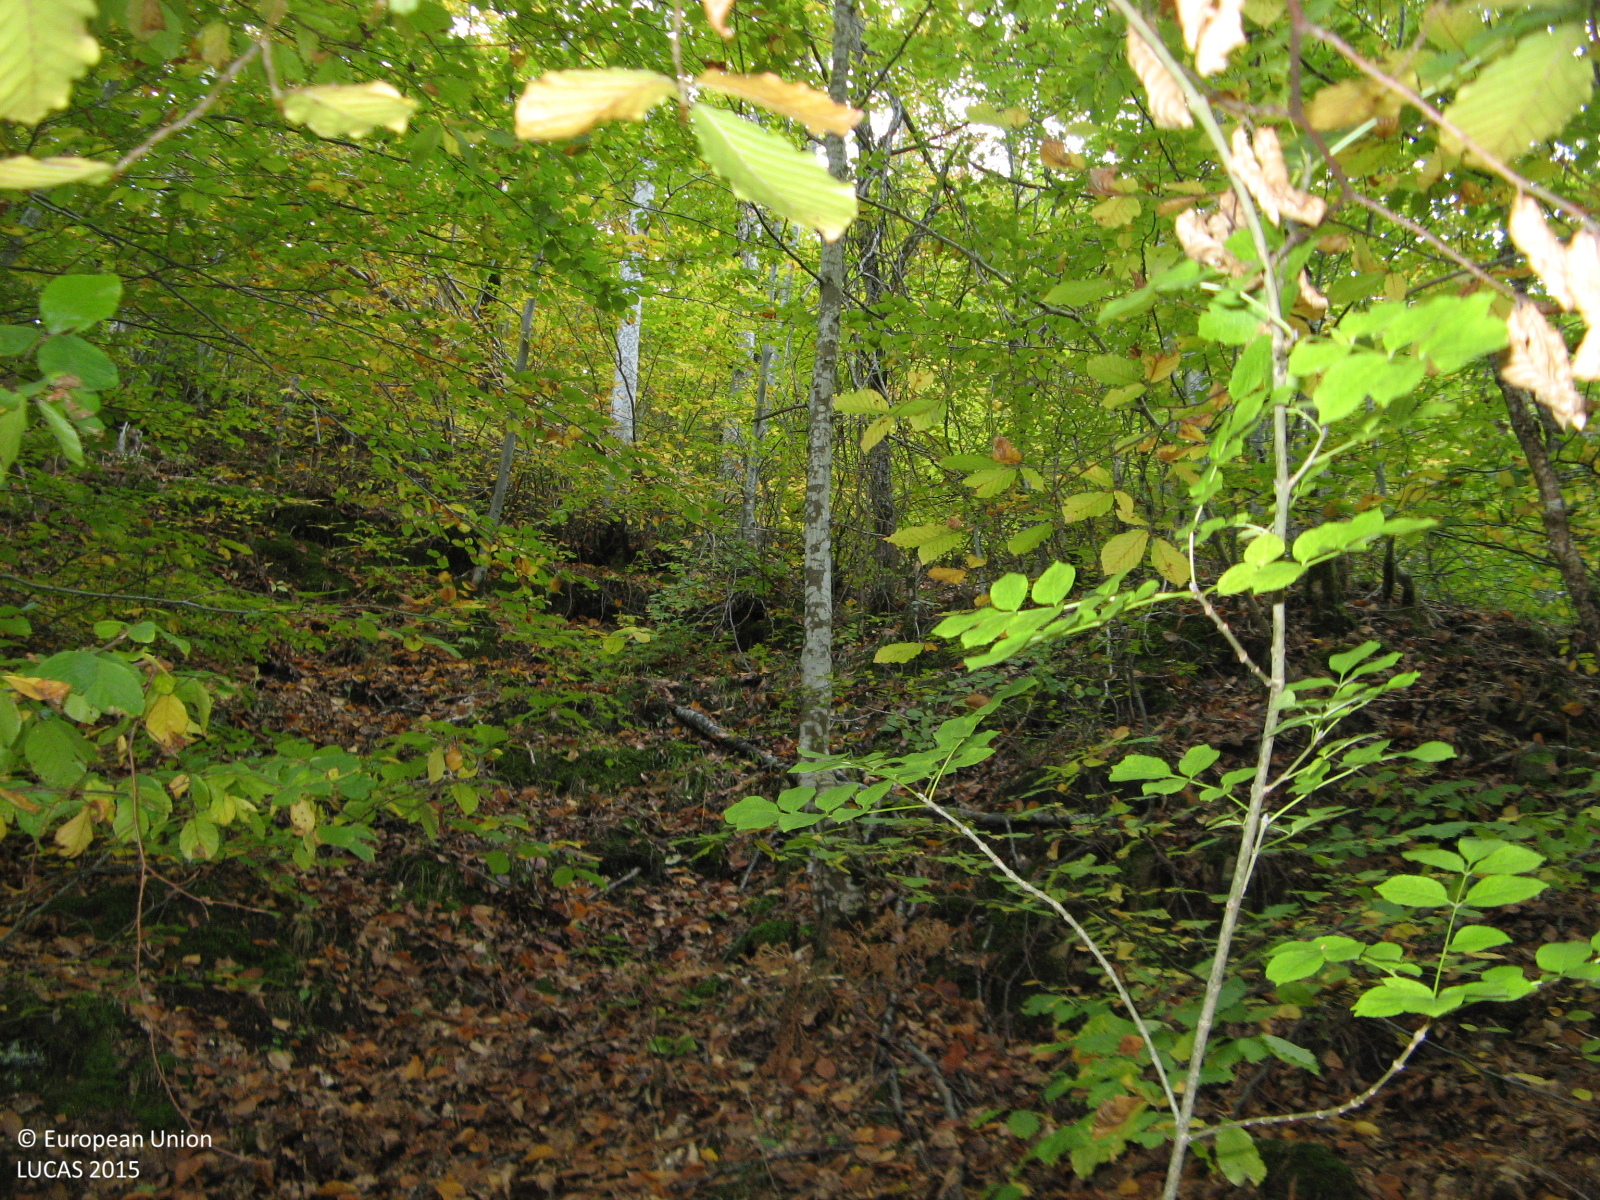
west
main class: Woodland
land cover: Broadleaved woodland
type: mountainous beech forest
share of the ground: > 75 %
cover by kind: broadleaved forest trees 95 %, unconsolidated bare surface 5 %
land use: Forestry
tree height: > 5 m
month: October
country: BG
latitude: 41.4140
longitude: 24.7945
